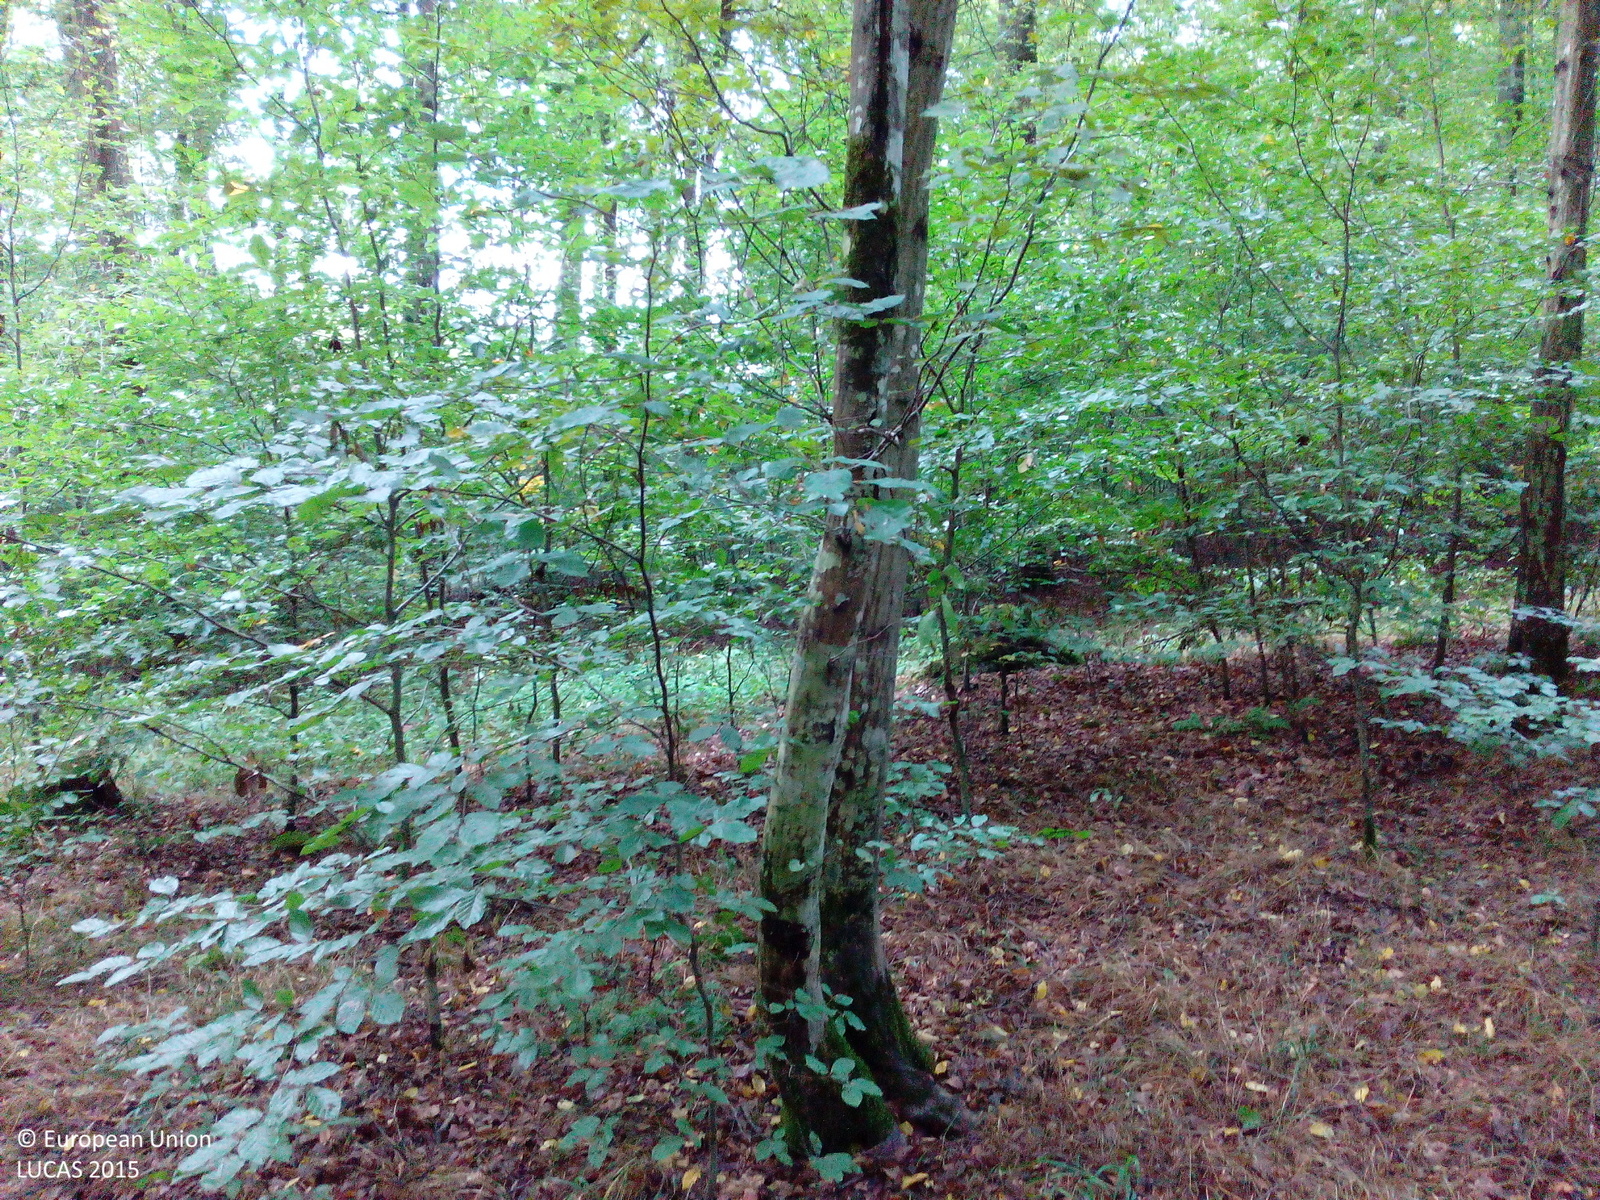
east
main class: Woodland
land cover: Broadleaved woodland
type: beech forest
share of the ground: > 75 %
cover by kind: broadleaved forest trees 95 %, herbaceous plants 5 %
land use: Forestry
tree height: > 5 m
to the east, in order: Broadleaved woodland; Tracks; Broadleaved woodland; Tracks; Spruce dominated mixed woodland; Tracks; Spruce dominated mixed woodland; Broadleaved woodland; Groves; Grass margins; Tracks; Grass margins; Broadleaved woodland; Tracks; Broadleaved woodland
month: September
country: DE
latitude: 49.9145
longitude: 9.9582
